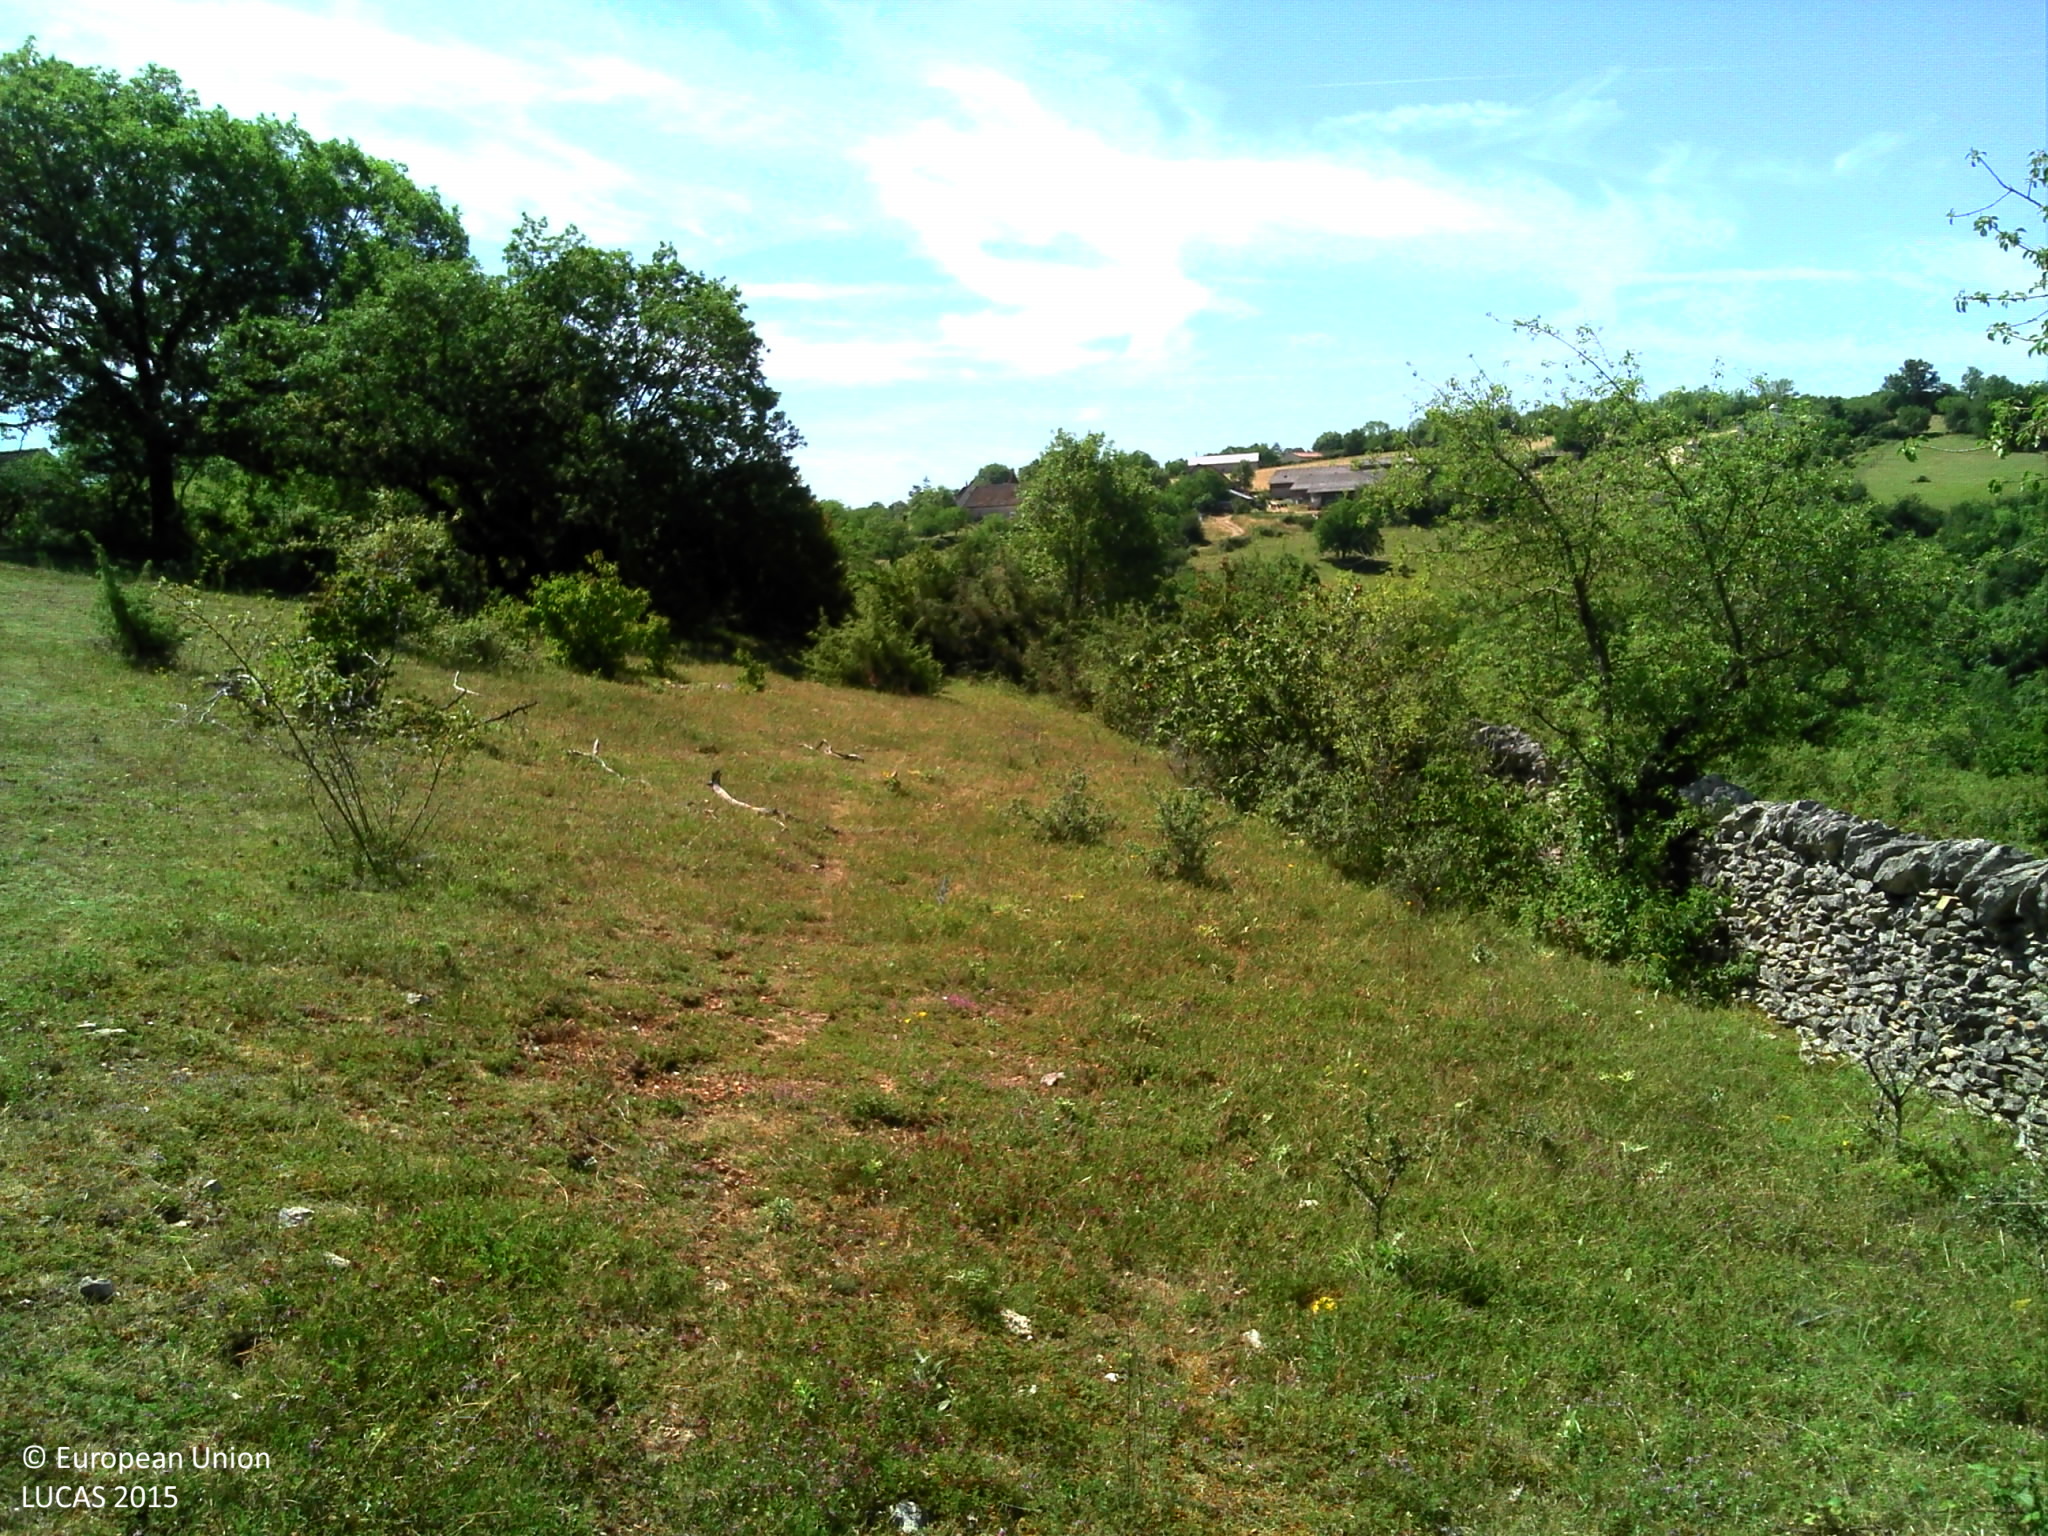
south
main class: Grassland
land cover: Grassland with sparse tree/shrub cover
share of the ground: > 75 %
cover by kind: herbaceous plants 95 %, broadleaved forest trees 5 %
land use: Agriculture (excluding fallow land and kitchen gardens)
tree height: < 5 m
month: June
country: FR
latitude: 44.8439
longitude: 1.6092
